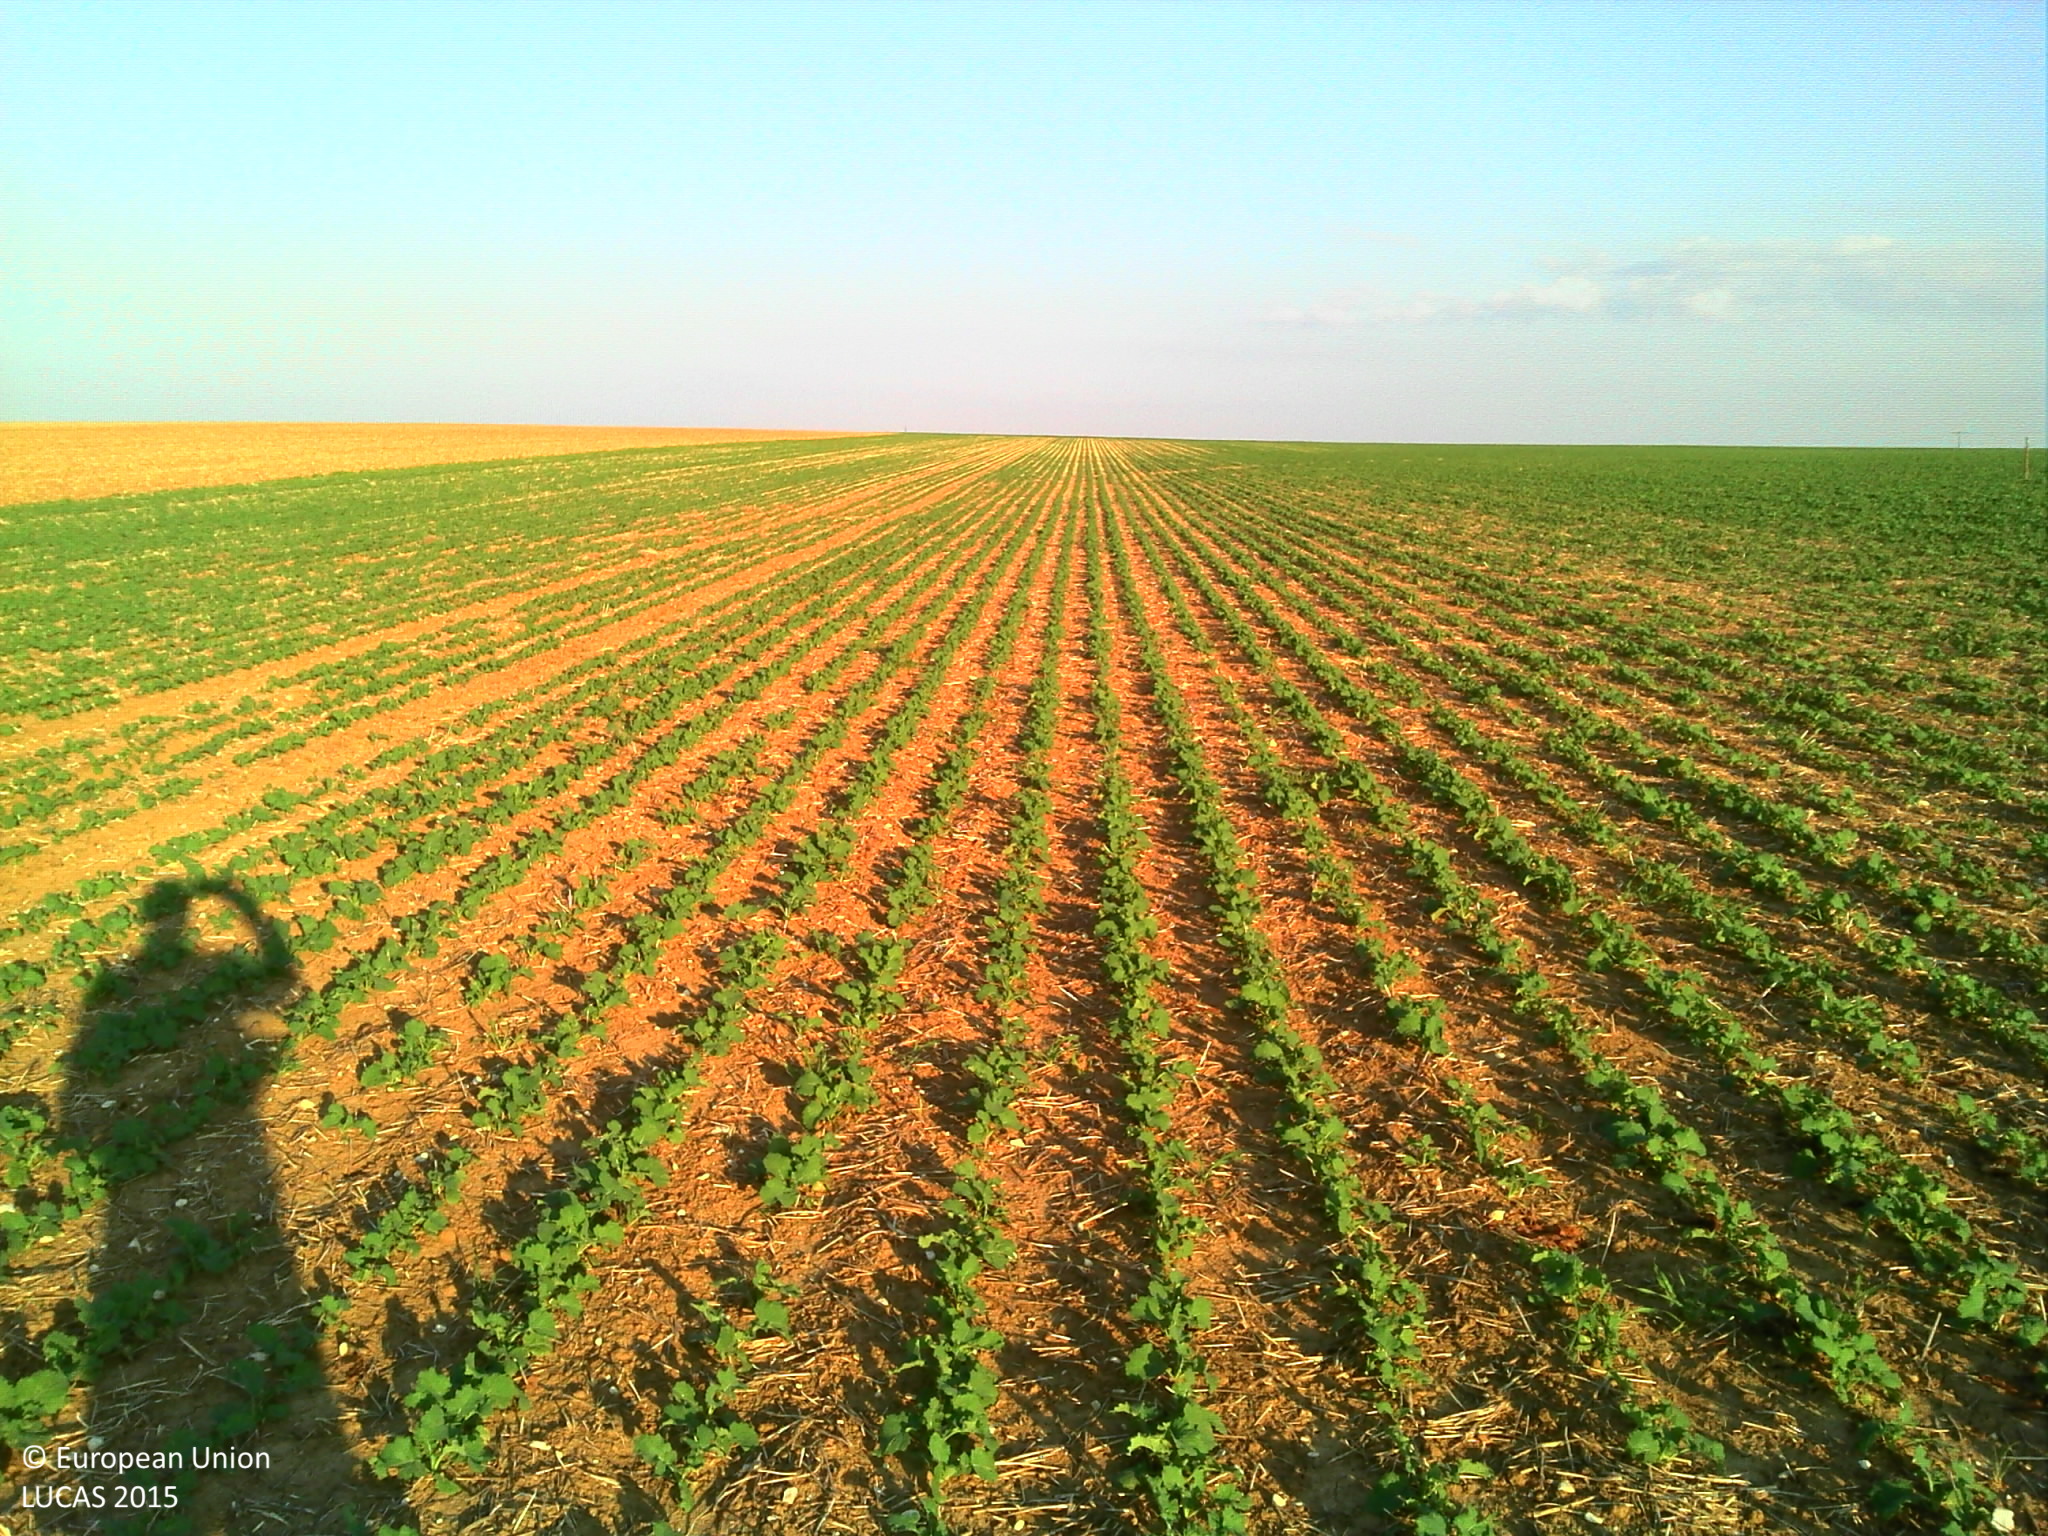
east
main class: Cropland
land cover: Rape and turnip rape
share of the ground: 25 - 50 %
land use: Agriculture (excluding fallow land and kitchen gardens)
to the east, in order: Rape and turnip rape; Other bare soil
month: October
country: FR
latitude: 48.1116
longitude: 4.2889
